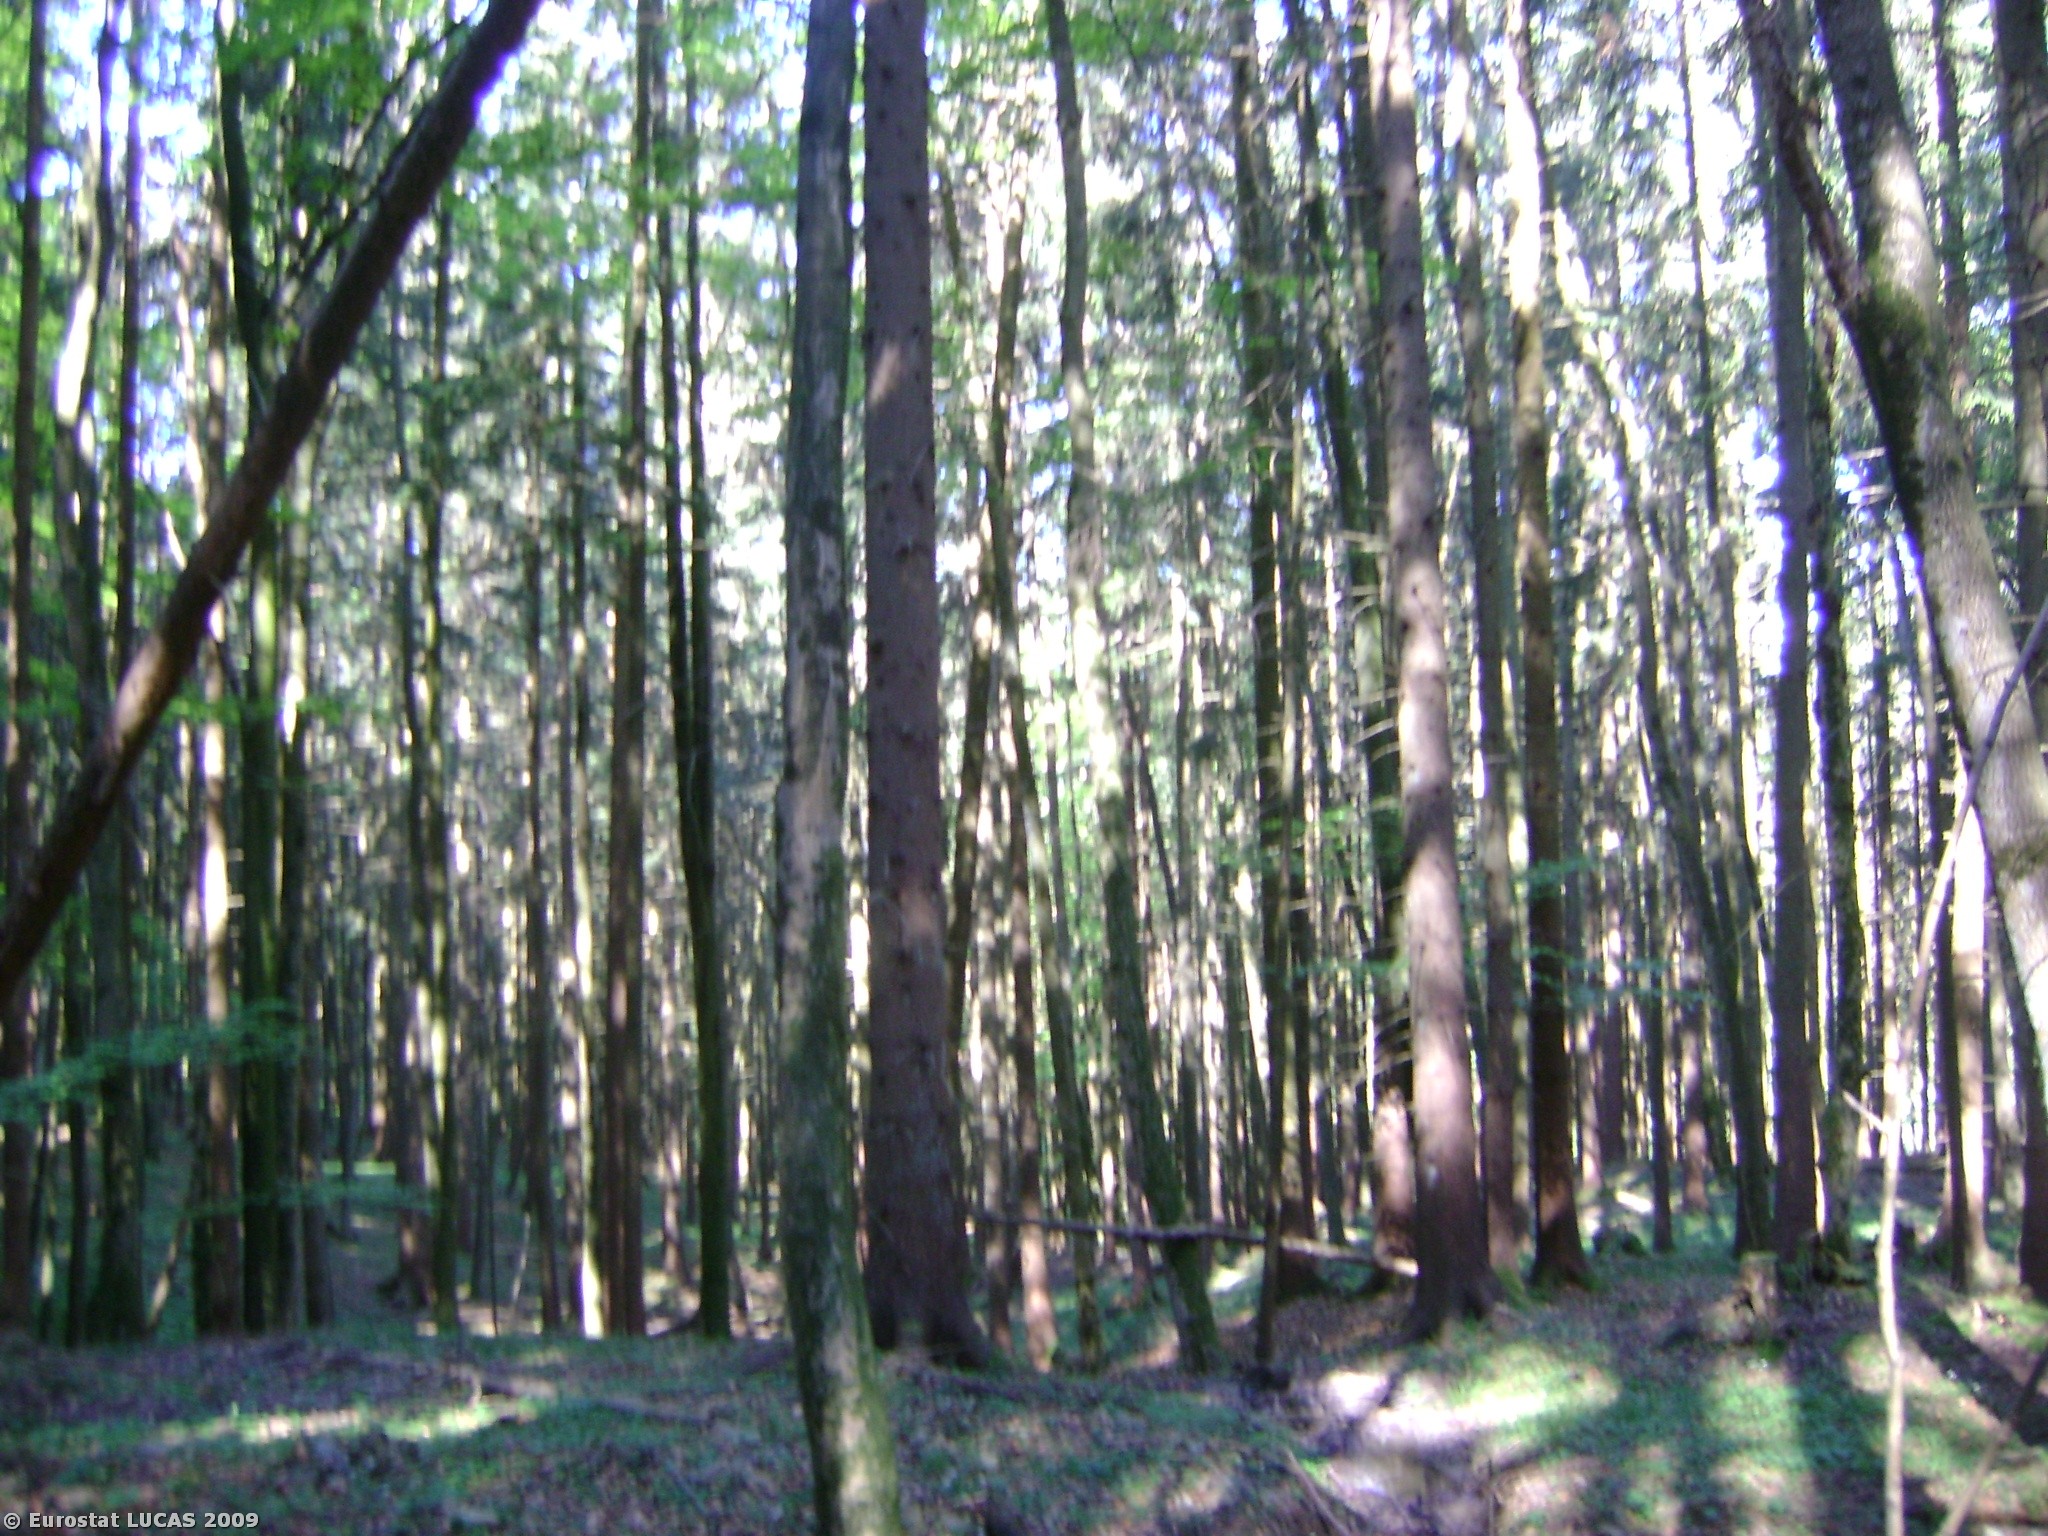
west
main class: Woodland
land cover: Mixed woodland
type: hemiboreal forest and nemoral coniferous forest and mixed broadleaved-coniferous forest
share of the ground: > 75 %
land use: Forestry
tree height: > 5 m
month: May
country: AT
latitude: 47.8883
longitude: 13.2219
